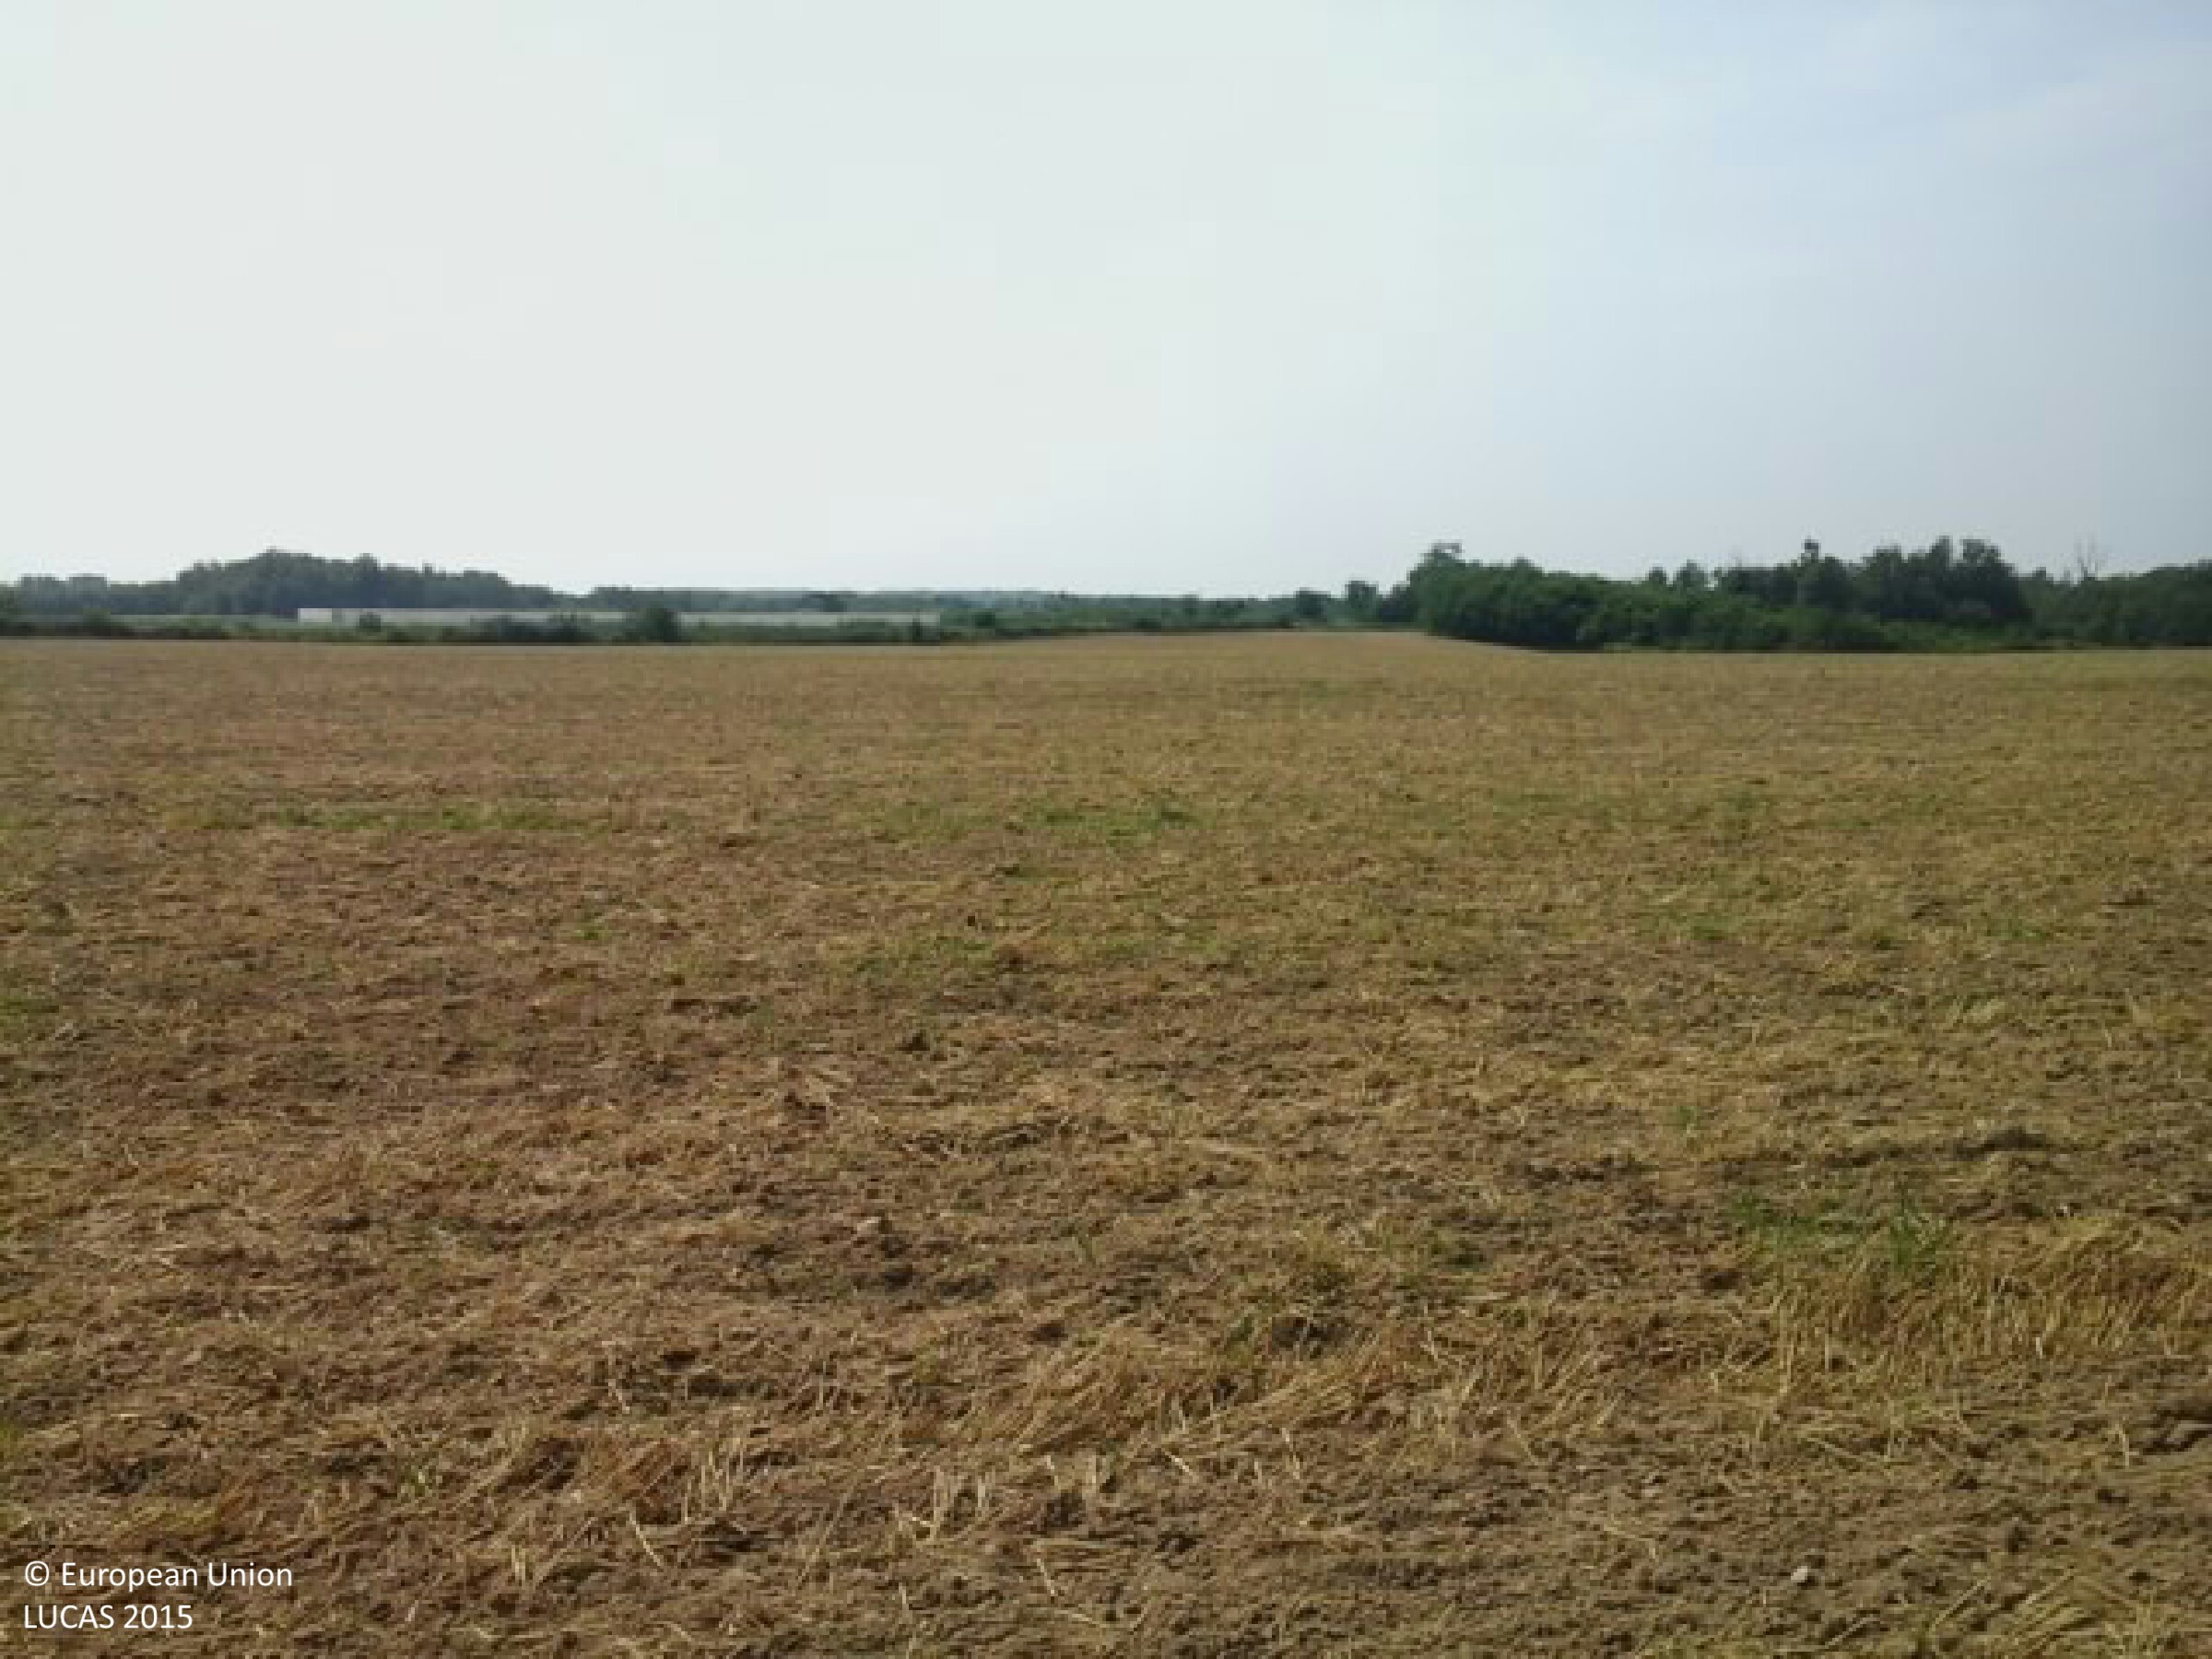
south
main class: Cropland
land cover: Common wheat
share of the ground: < 10 %
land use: Agriculture (excluding fallow land and kitchen gardens)
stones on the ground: < 10 %
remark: Harvested field
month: August
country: HU
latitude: 46.3835
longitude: 17.1414
